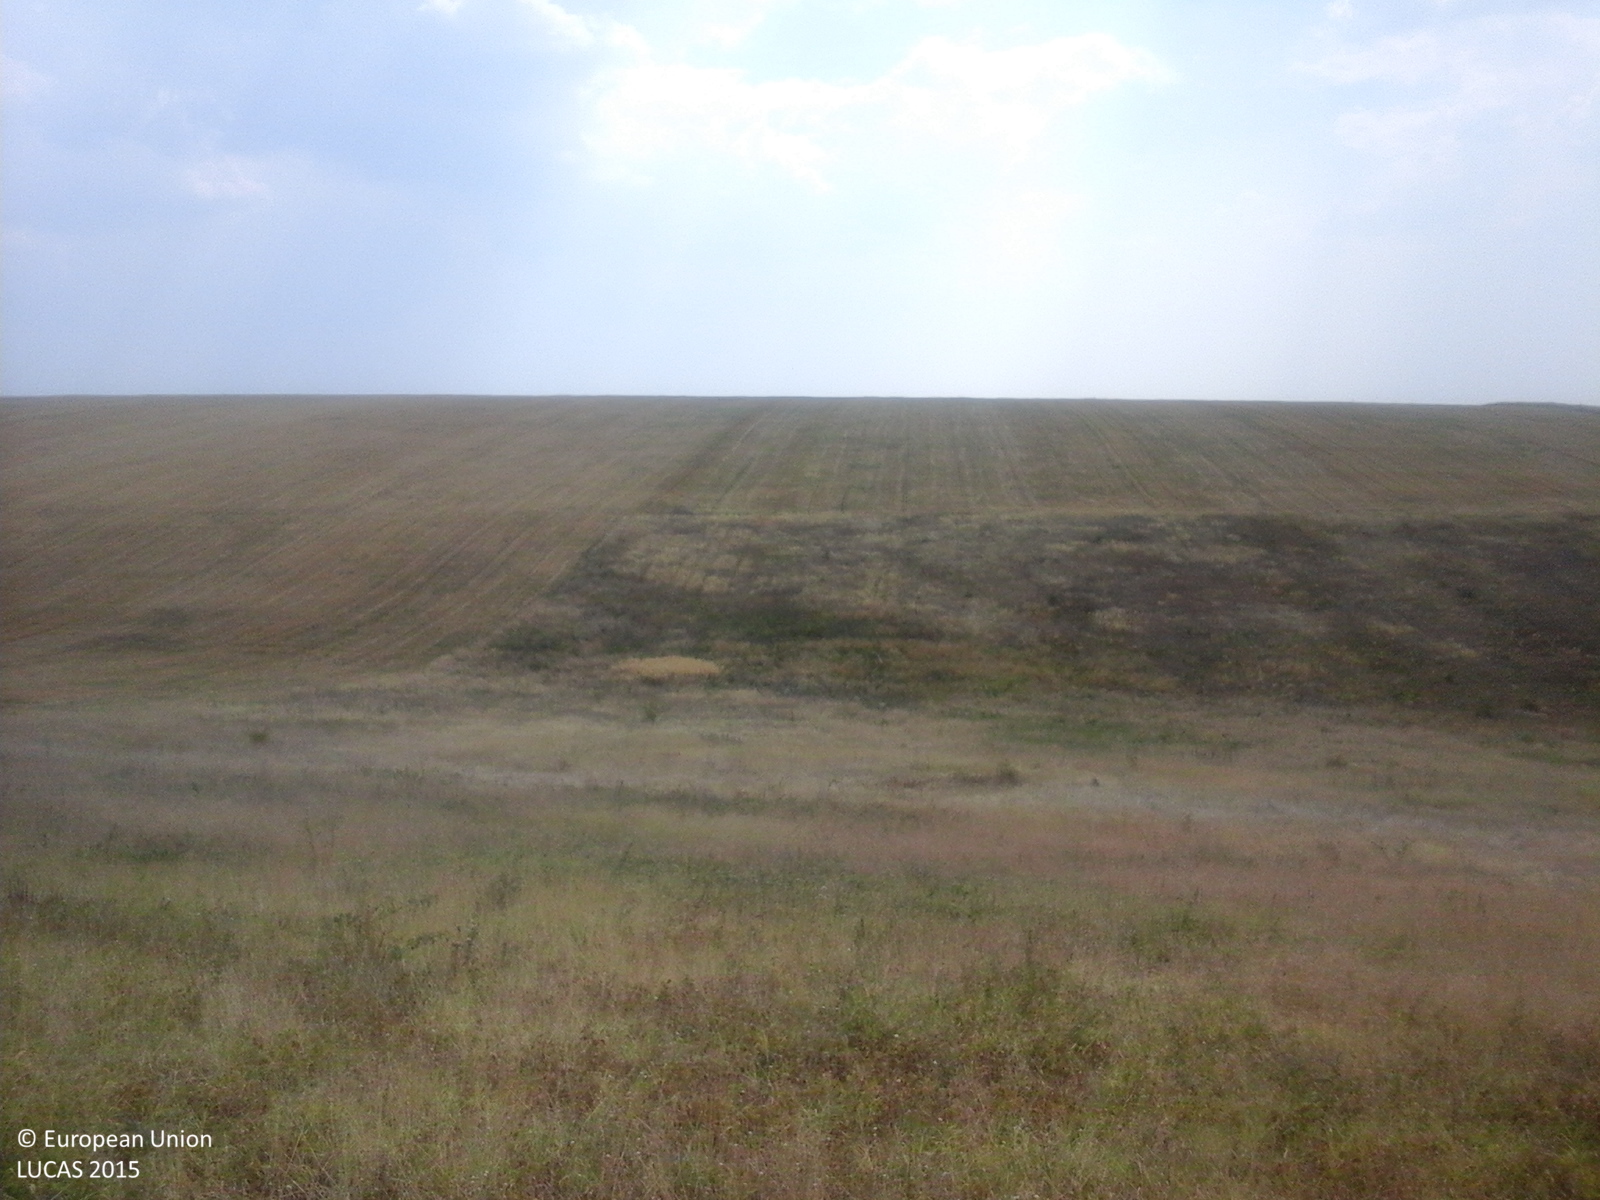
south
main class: Grassland
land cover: Spontaneously vegetated surfaces
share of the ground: > 75 %
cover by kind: herbaceous plants 100 %
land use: Fallow land
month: August
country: RO
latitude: 44.3736
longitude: 22.9577
